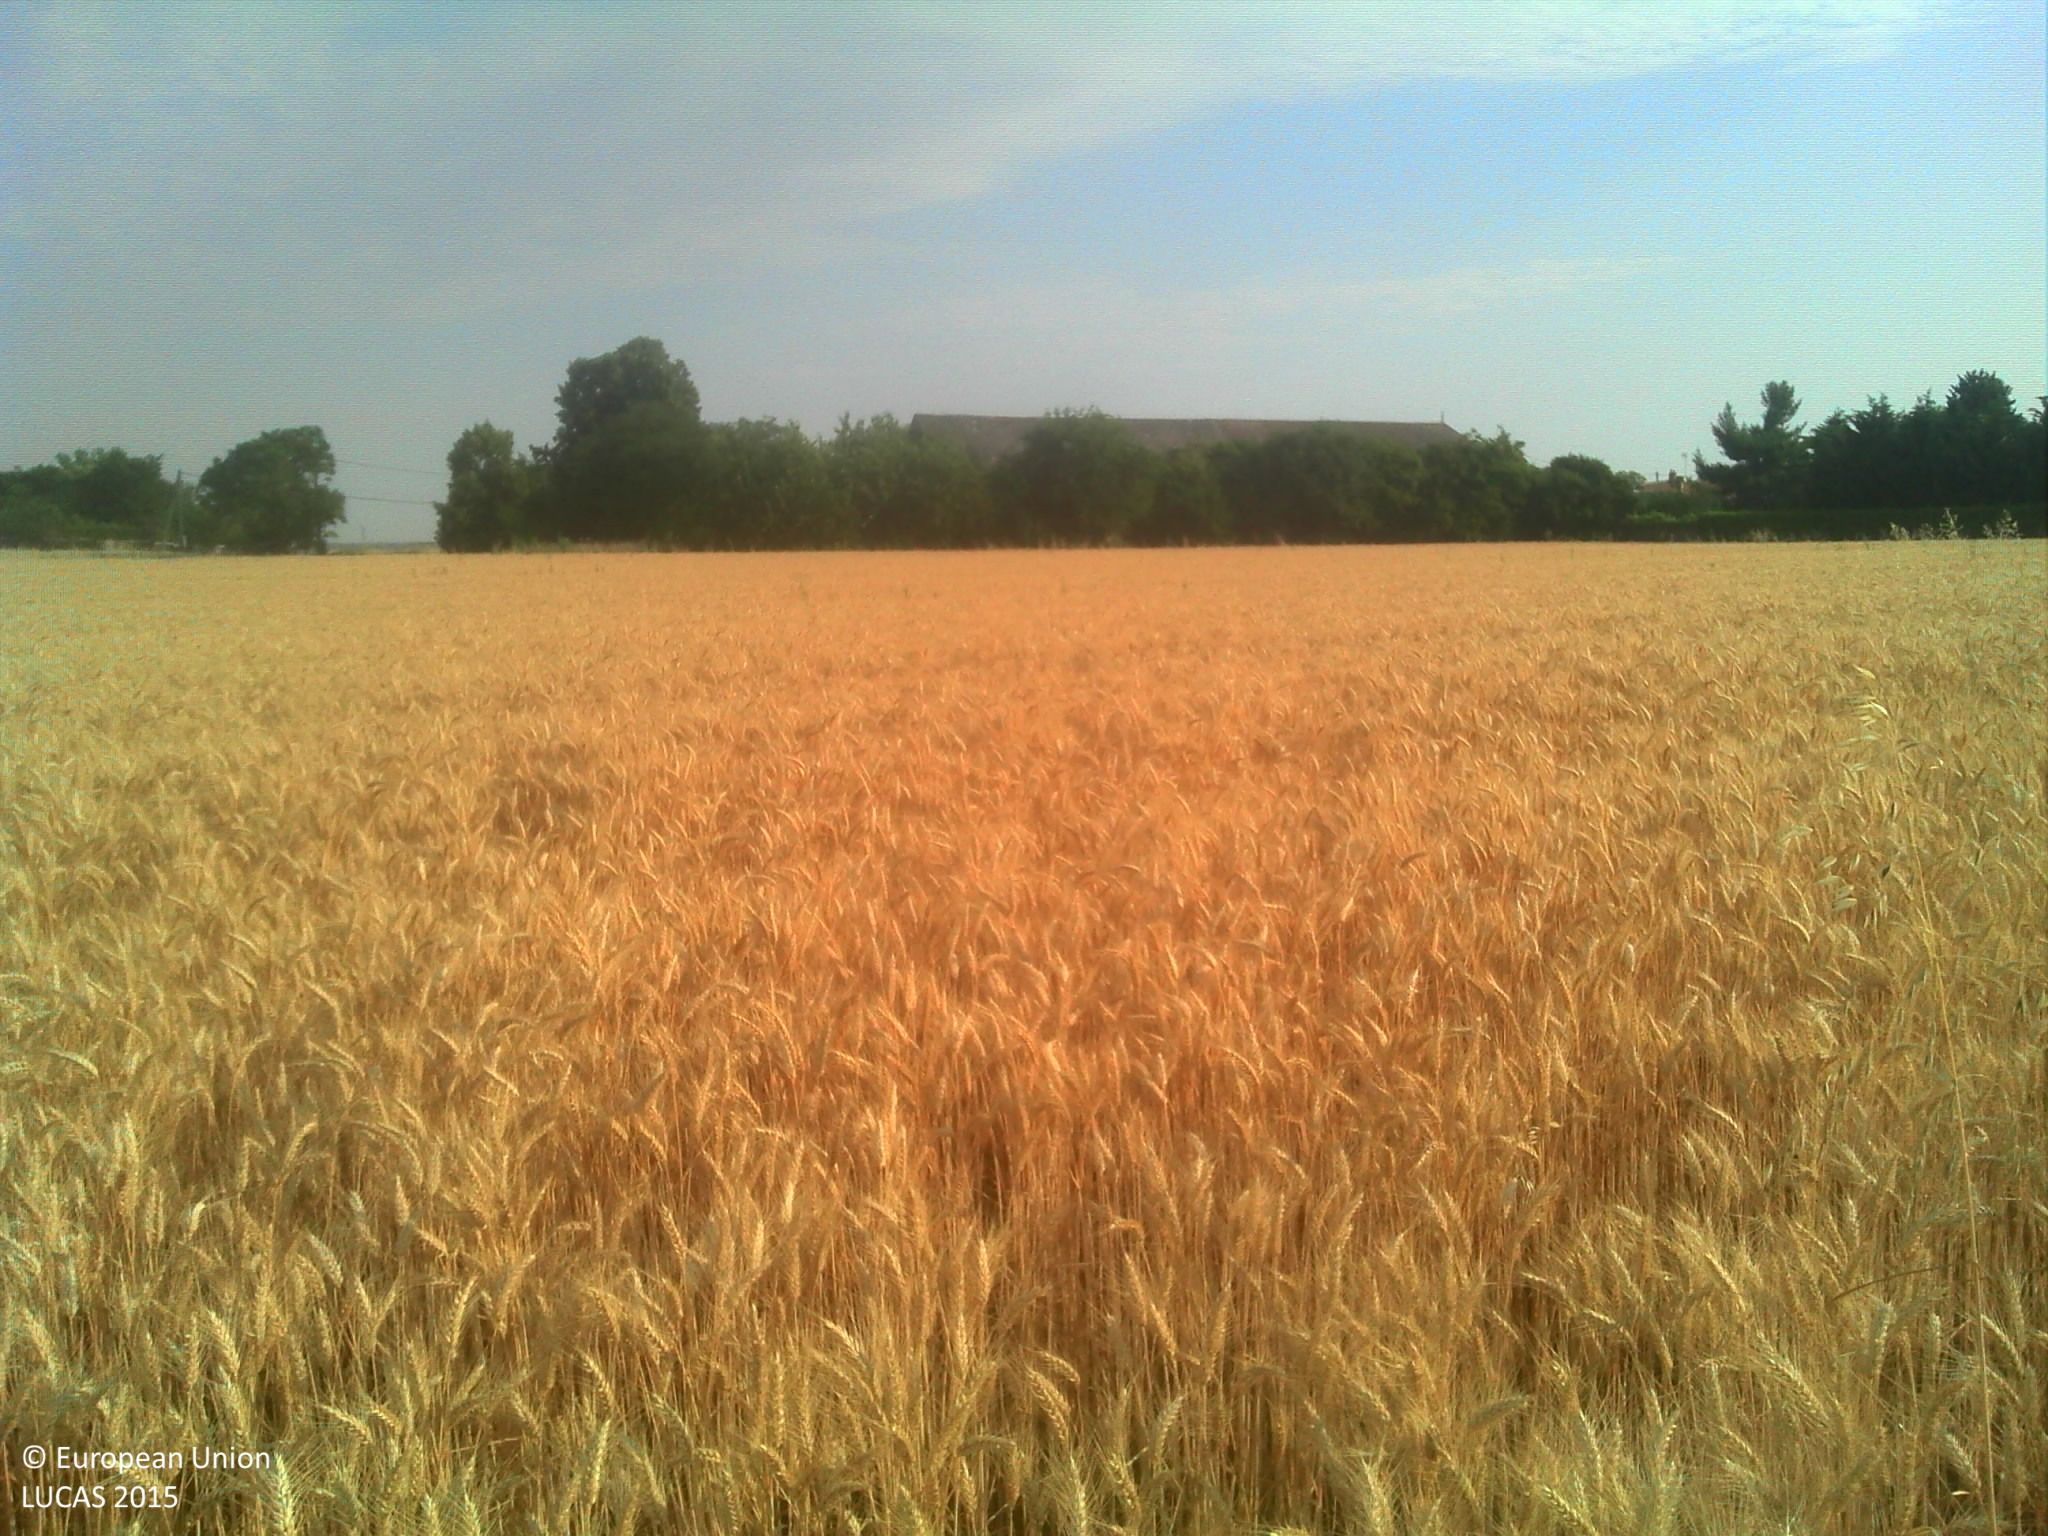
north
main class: Cropland
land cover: Durum wheat
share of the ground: > 75 %
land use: Agriculture (excluding fallow land and kitchen gardens)
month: July
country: FR
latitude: 47.6316
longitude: 1.3743
